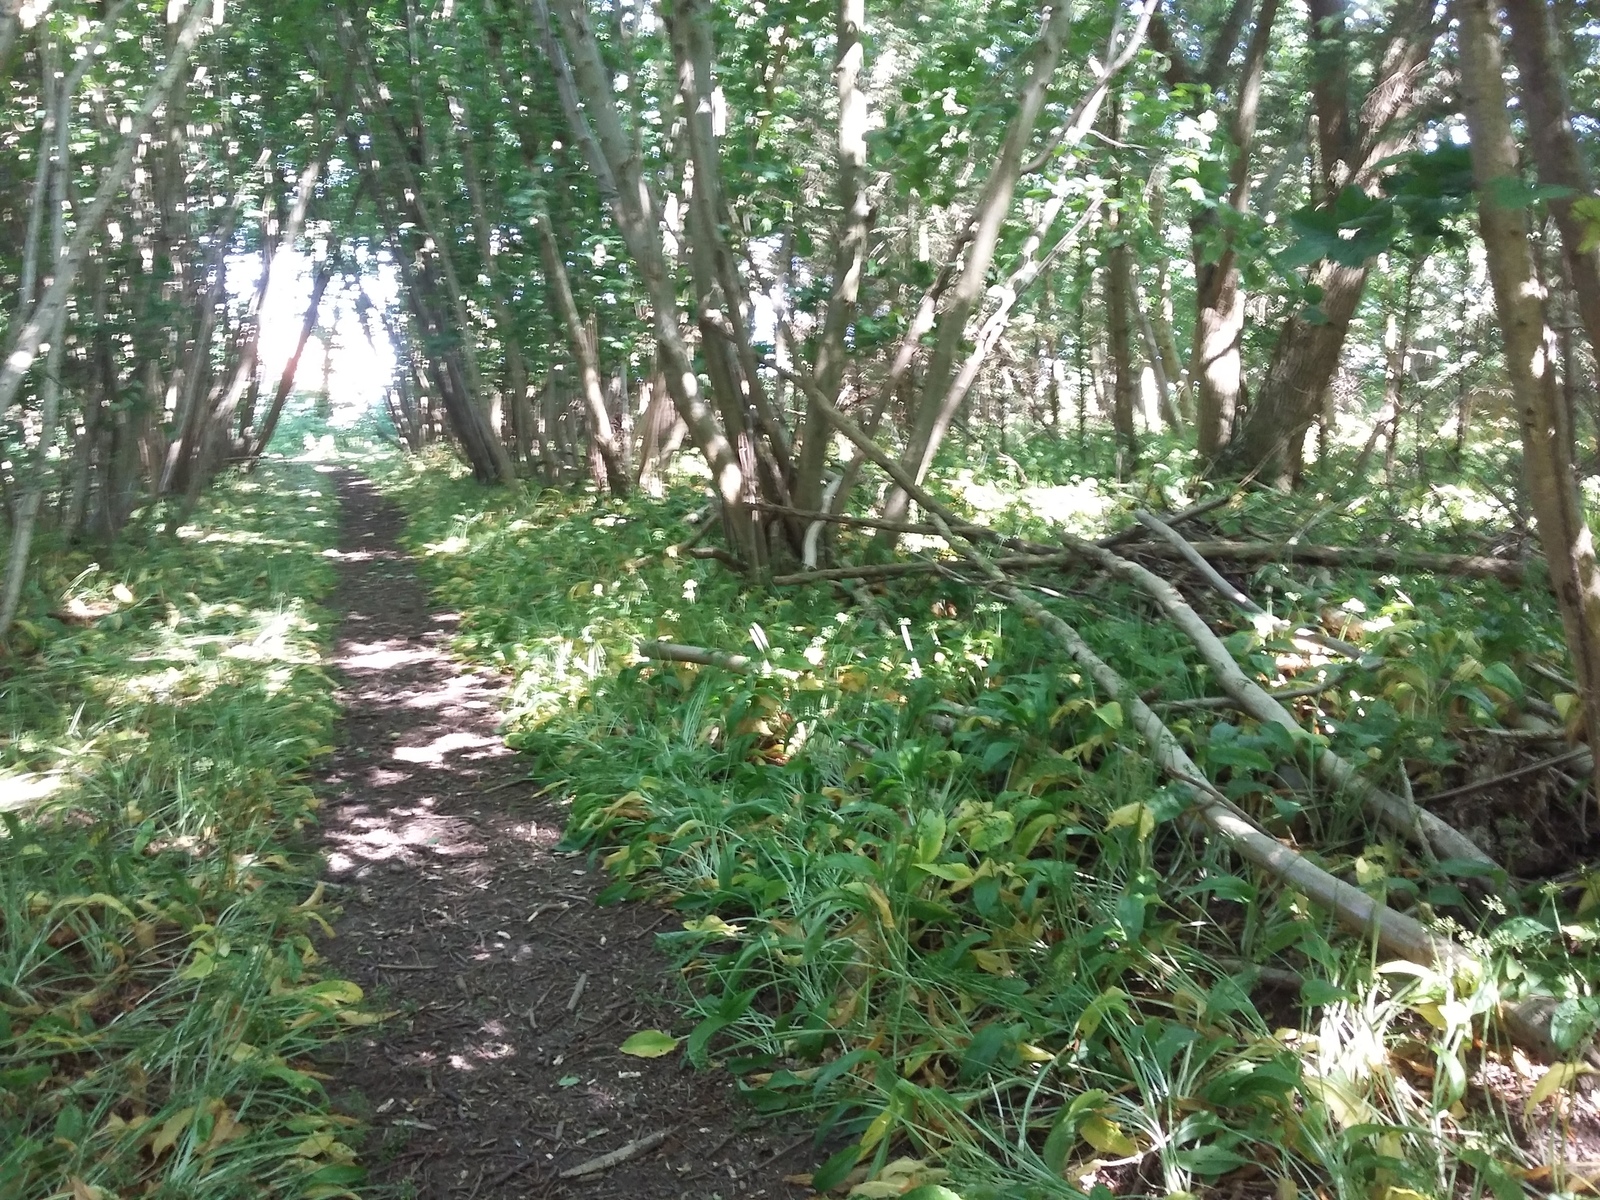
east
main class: Woodland
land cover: Broadleaved woodland
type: beech forest
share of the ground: > 75 %
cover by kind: broadleaved forest trees 80 %, coniferous forest trees 10 %, herbaceous plants 10 %
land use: Forestry
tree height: > 5 m
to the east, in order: Tracks; Broadleaved woodland; Artificial constructions in urban areas; Grass margins; Sugar beet
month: July
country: DK
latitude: 55.0392
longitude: 12.0173
